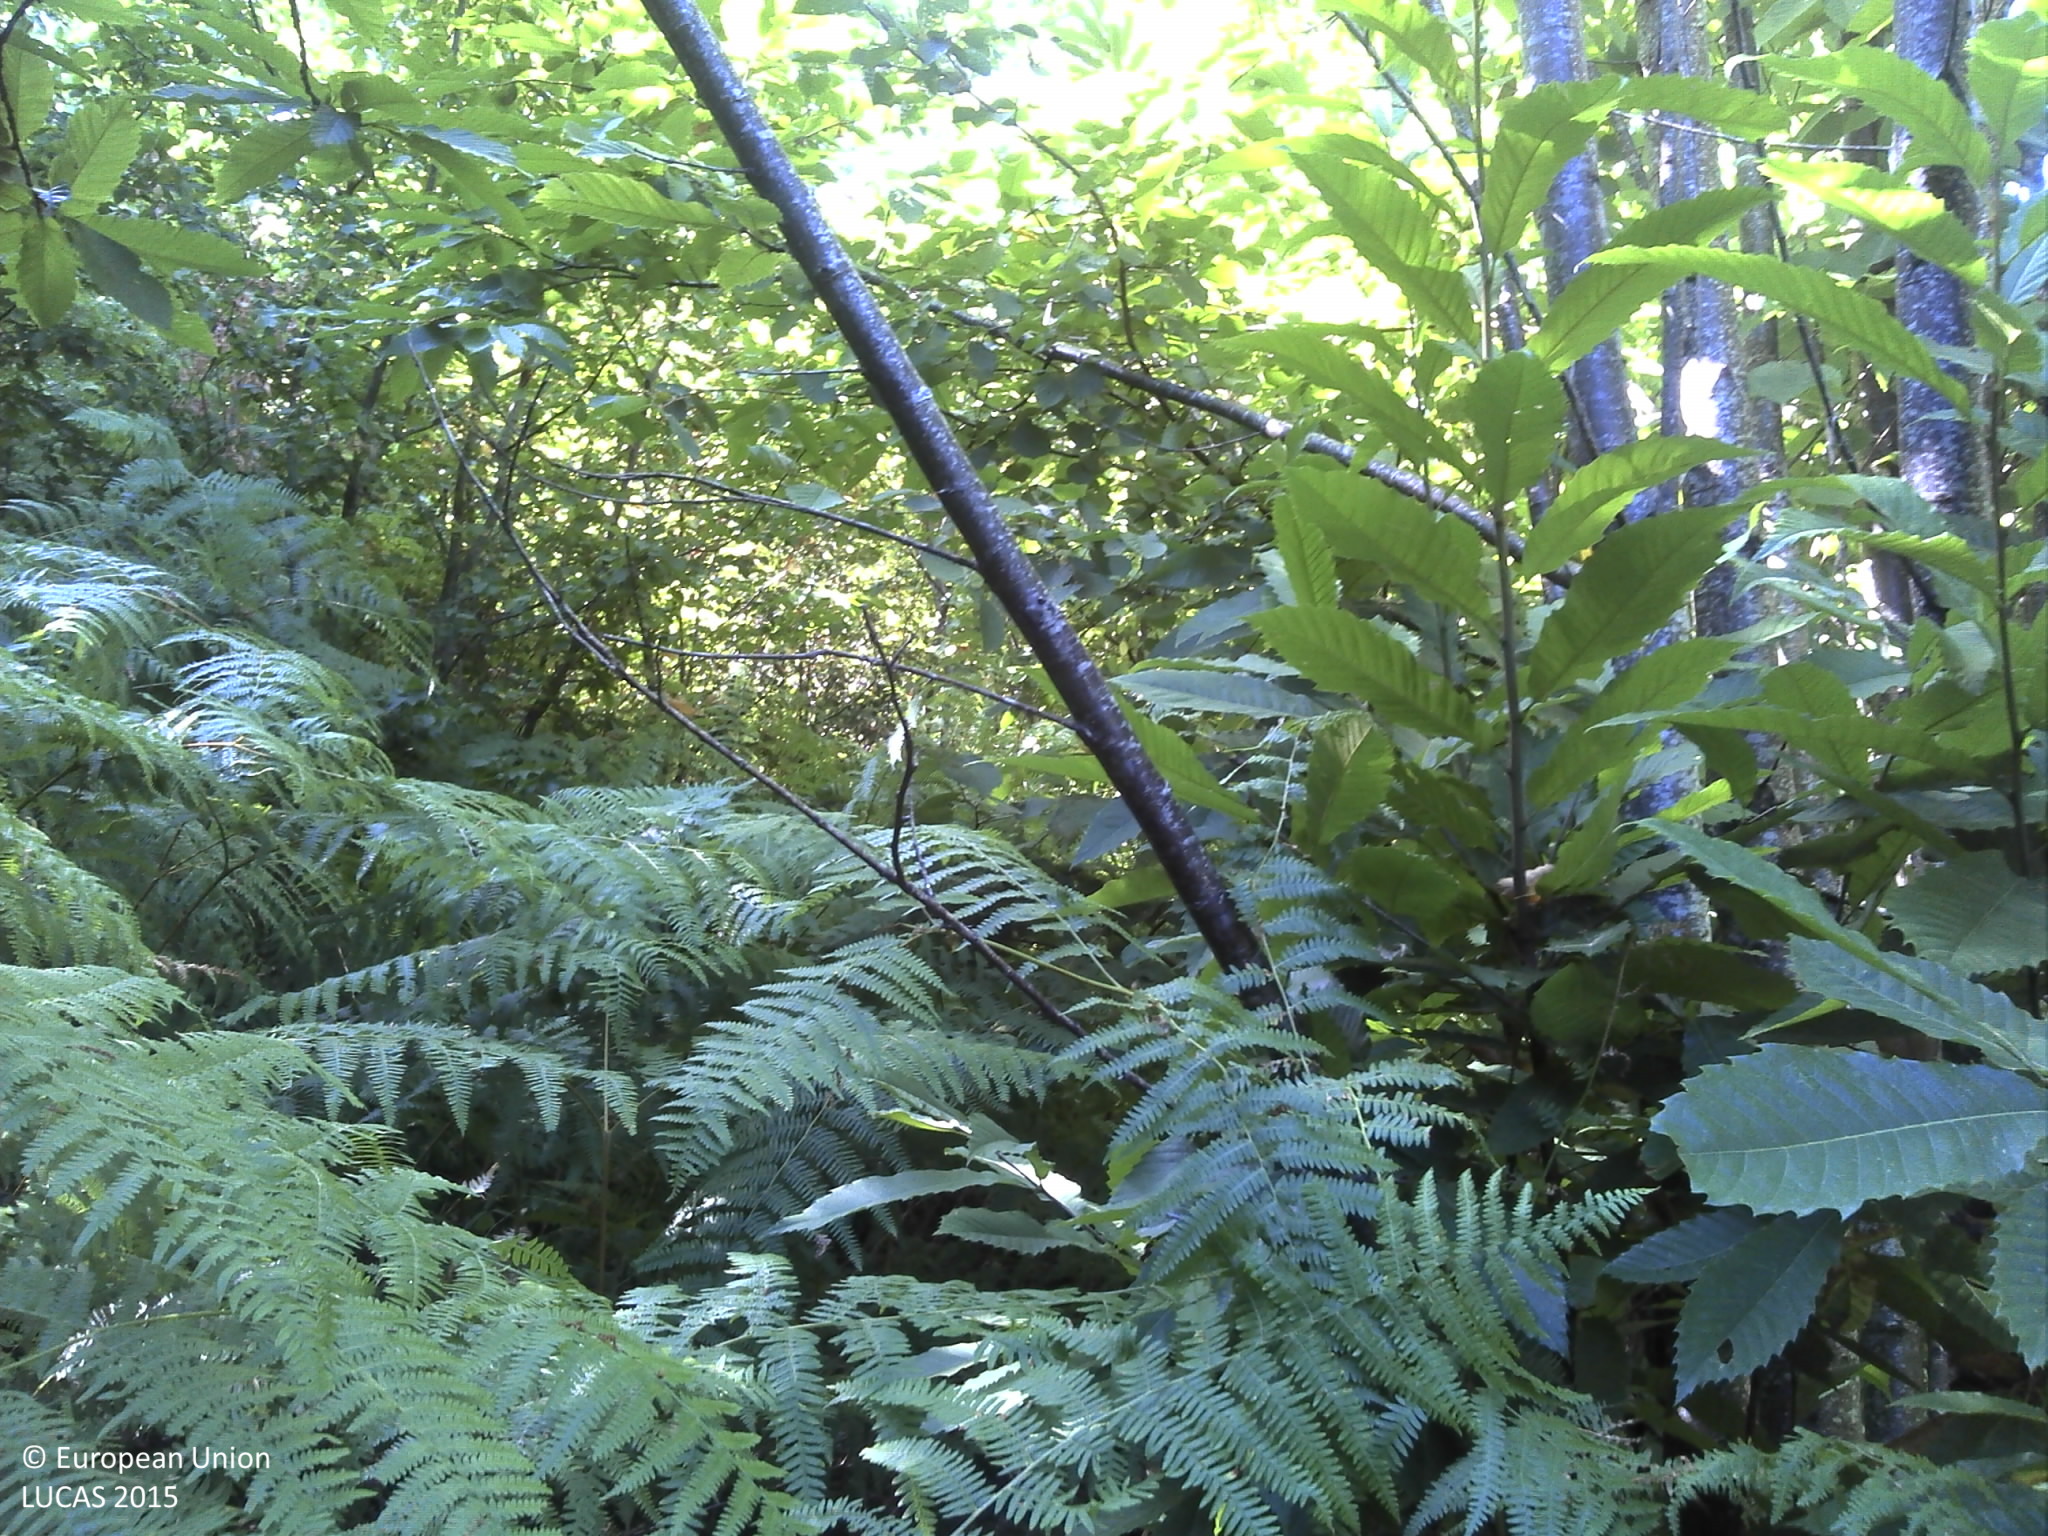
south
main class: Woodland
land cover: Broadleaved woodland
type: acidophilous oak and oak-birch forest
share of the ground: > 75 %
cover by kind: broadleaved forest trees 50 %, herbaceous plants 40 %, lichens and mosses 5 %, unconsolidated bare surface 5 %
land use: Forestry
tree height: > 5 m
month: July
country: FR
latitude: 45.0767
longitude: 1.8038
